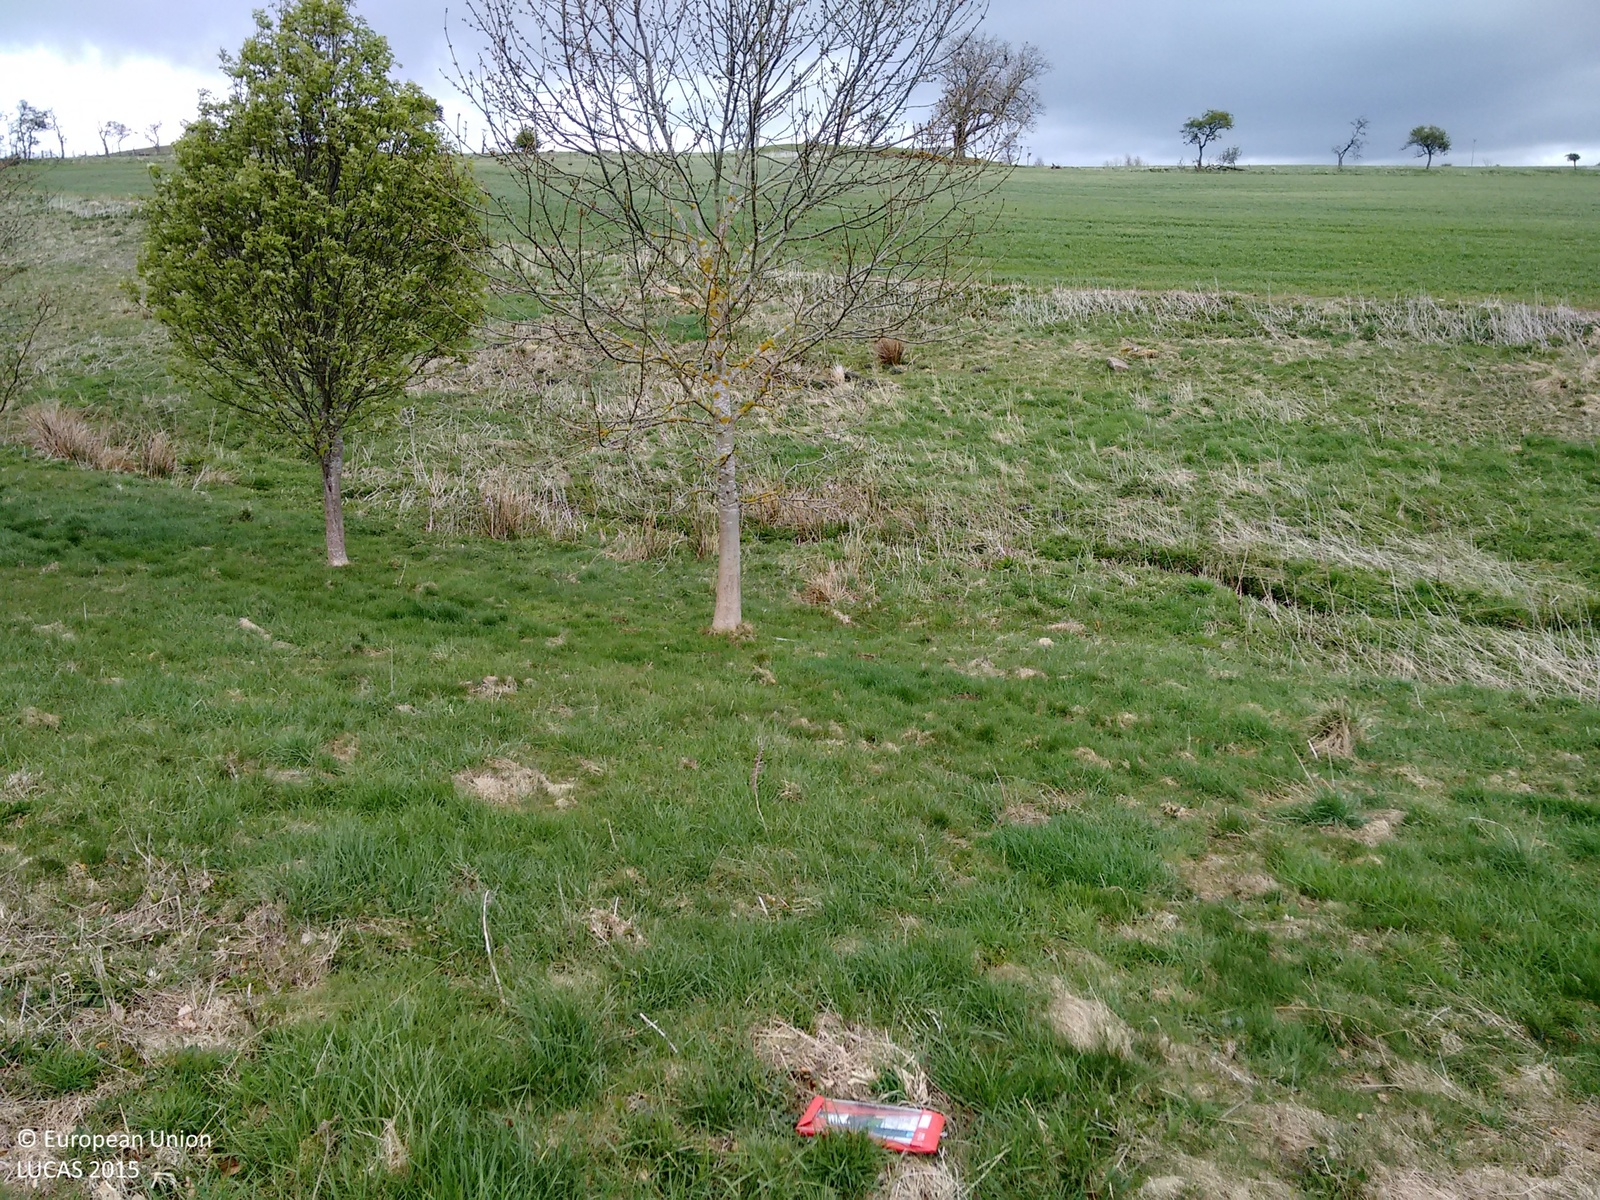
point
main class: Grassland
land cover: Grassland with sparse tree/shrub cover
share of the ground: > 75 %
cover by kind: herbaceous plants 95 %, broadleaved forest trees 5 %
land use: Semi-natural and natural areas not in use
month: May
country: GB
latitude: 54.8636
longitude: -1.9417
